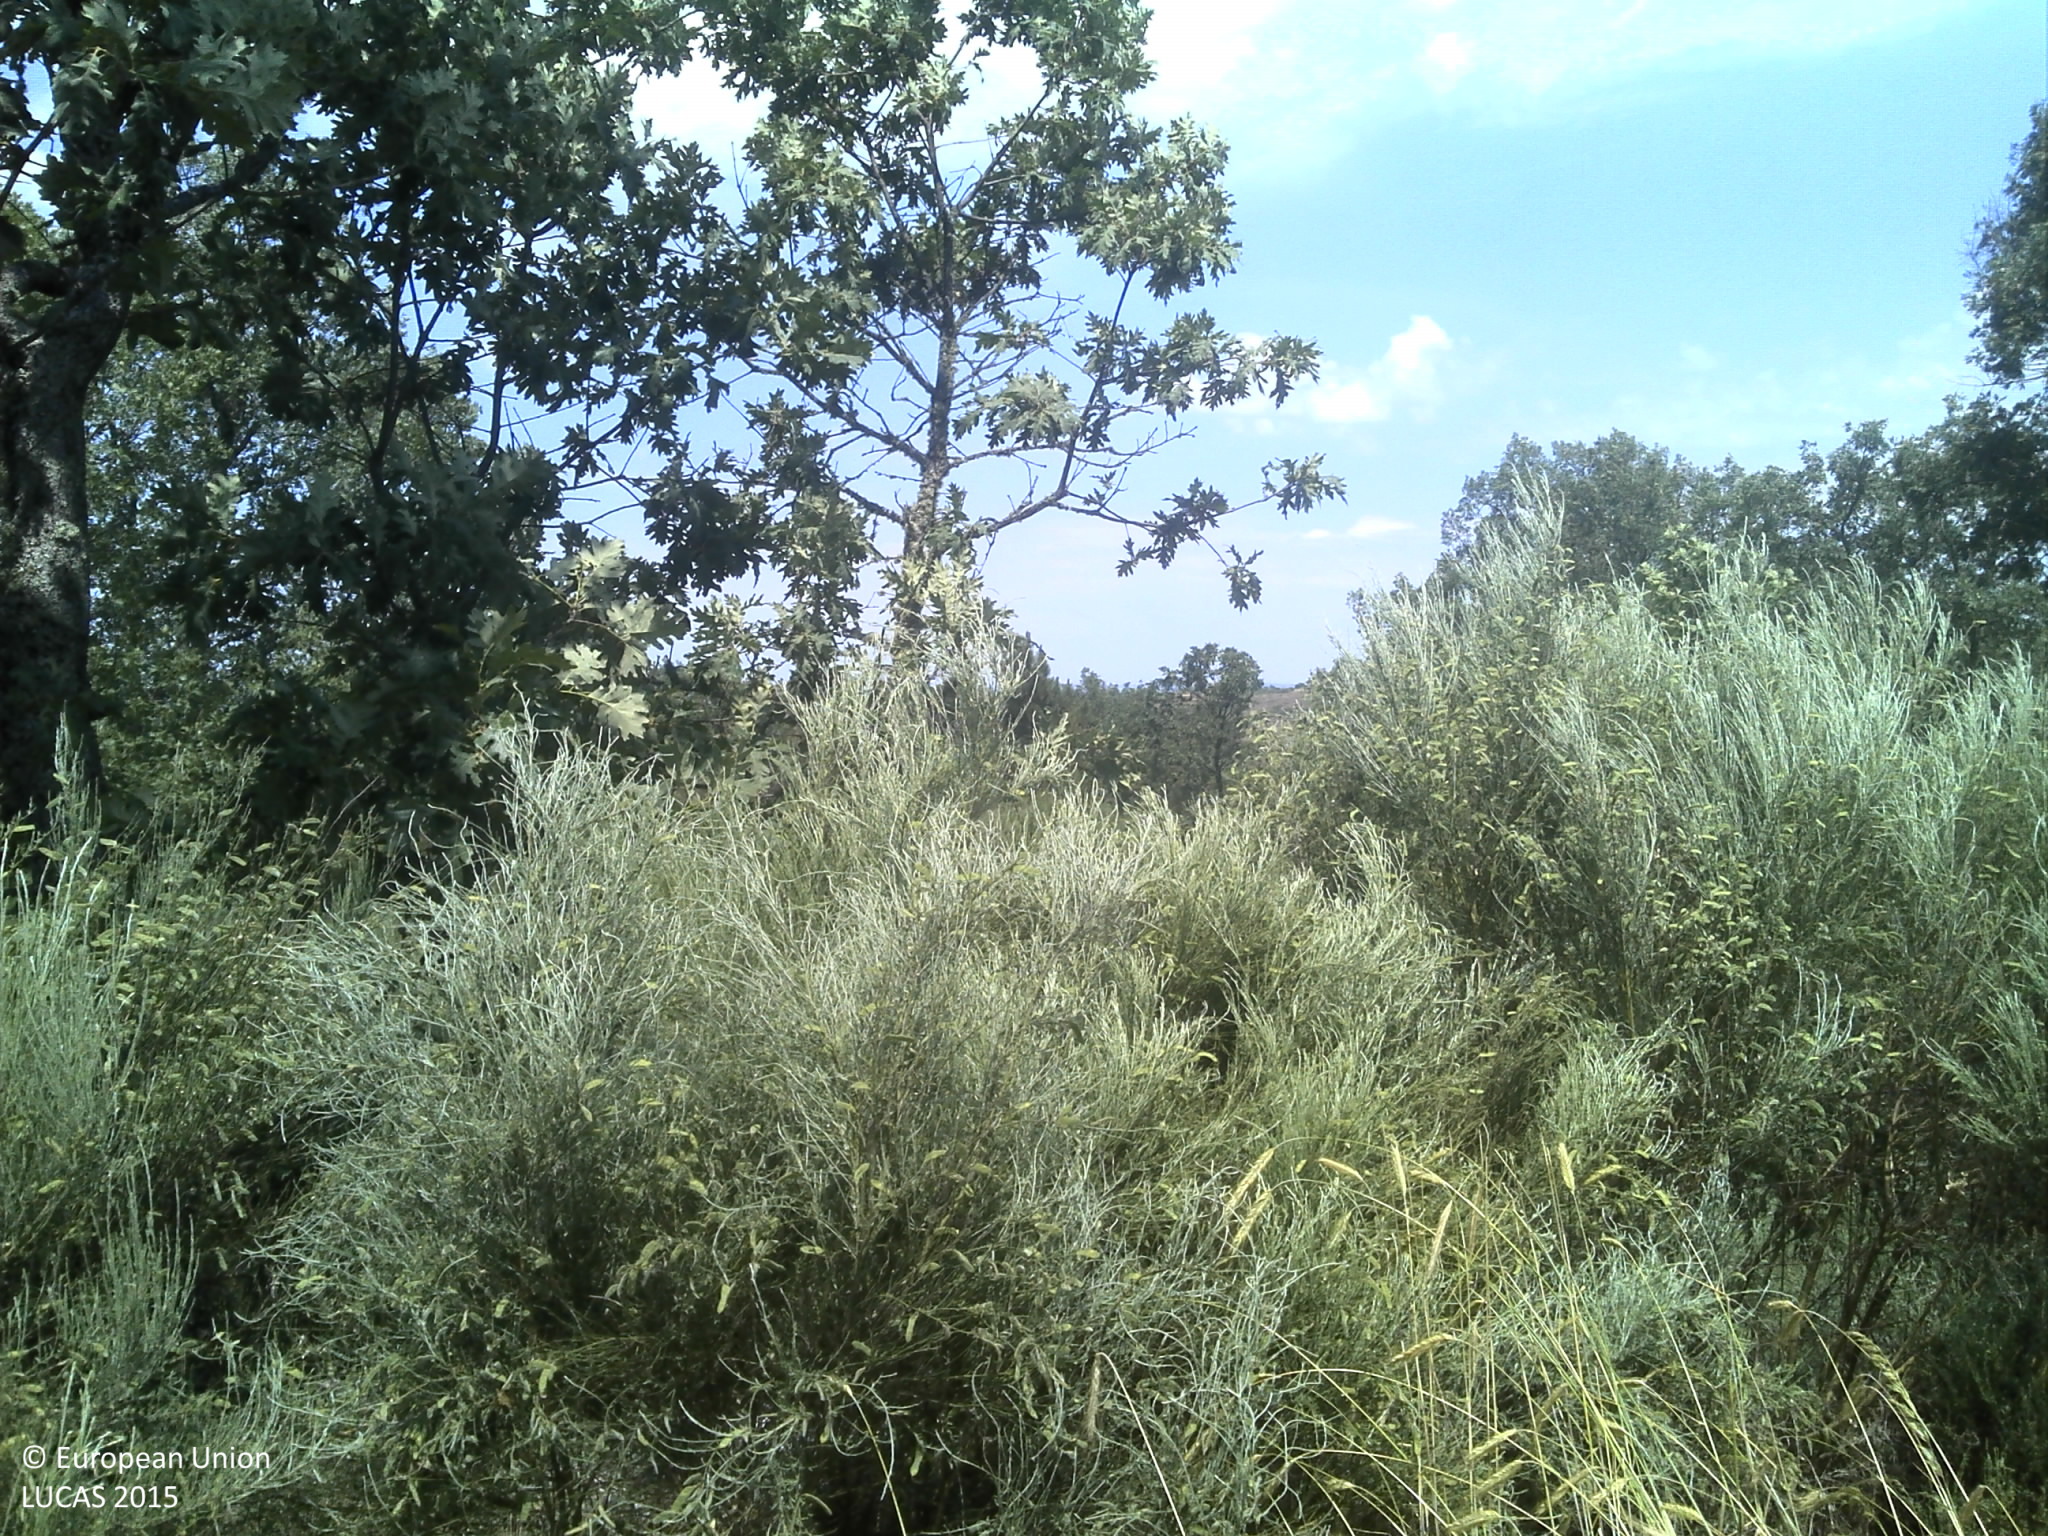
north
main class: Woodland
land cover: Broadleaved woodland
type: acidophilous oak and oak-birch forest
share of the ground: 50 - 75 %
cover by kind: broadleaved forest trees 50 %, shrubs 30 %, unconsolidated bare surface 20 %
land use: Forestry
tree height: > 5 m
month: June
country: PT
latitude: 40.3134
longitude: -6.9331
